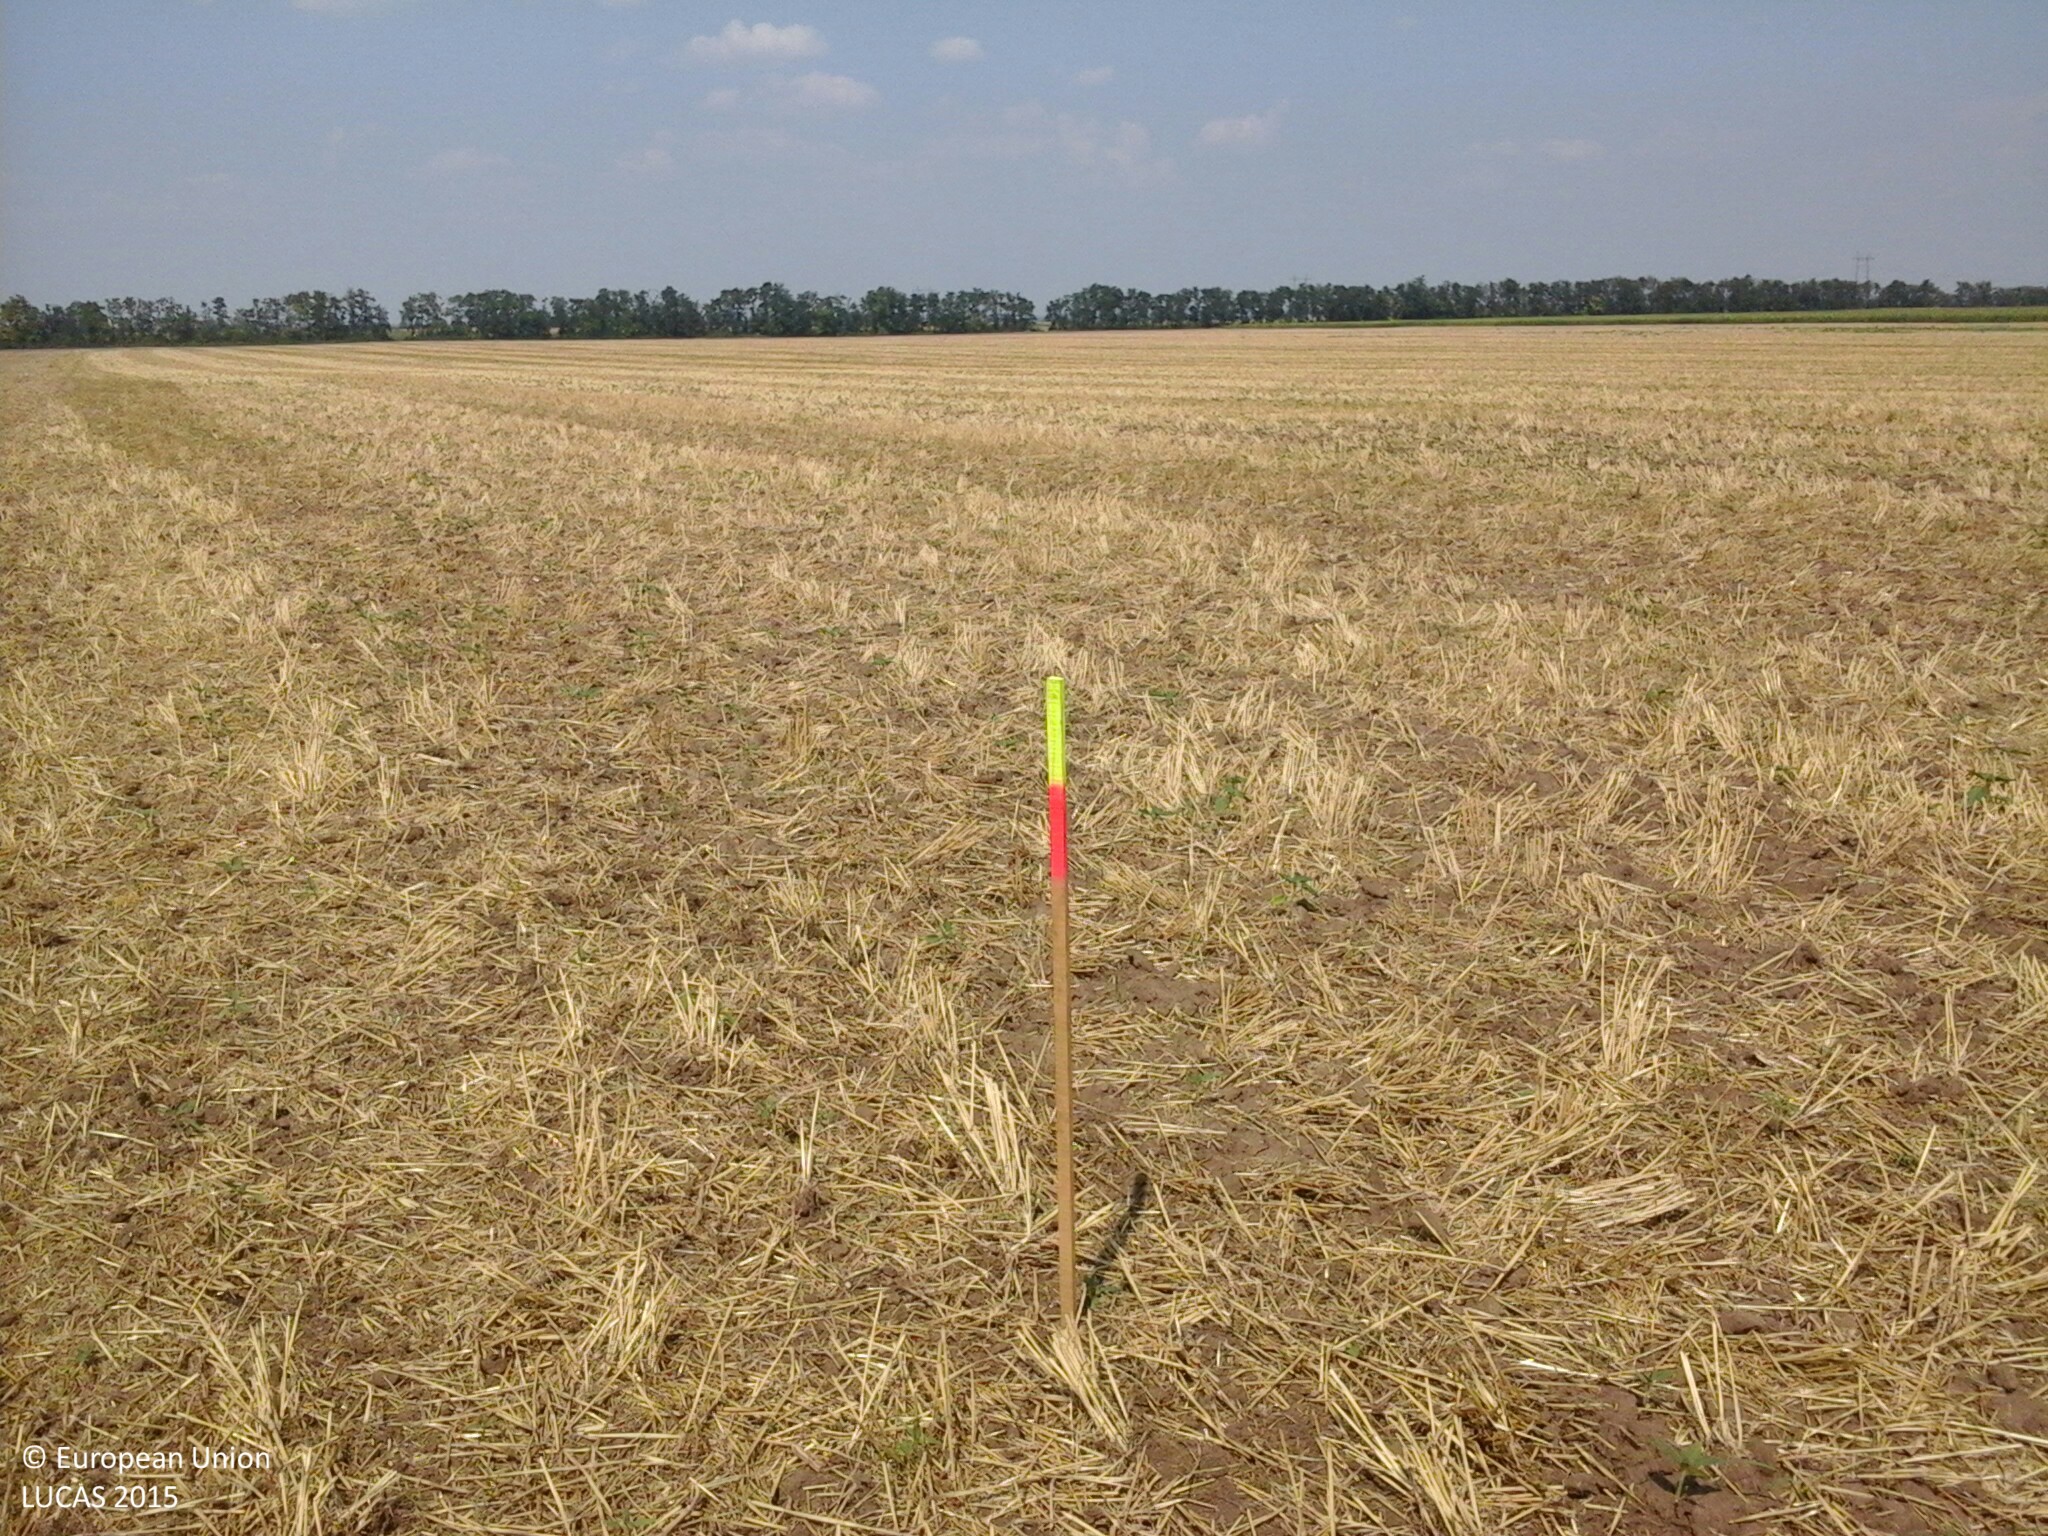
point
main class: Cropland
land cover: Common wheat
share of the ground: < 10 %
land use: Agriculture (excluding fallow land and kitchen gardens)
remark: Harvested field
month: August
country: HU
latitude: 46.8756
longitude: 18.3424
